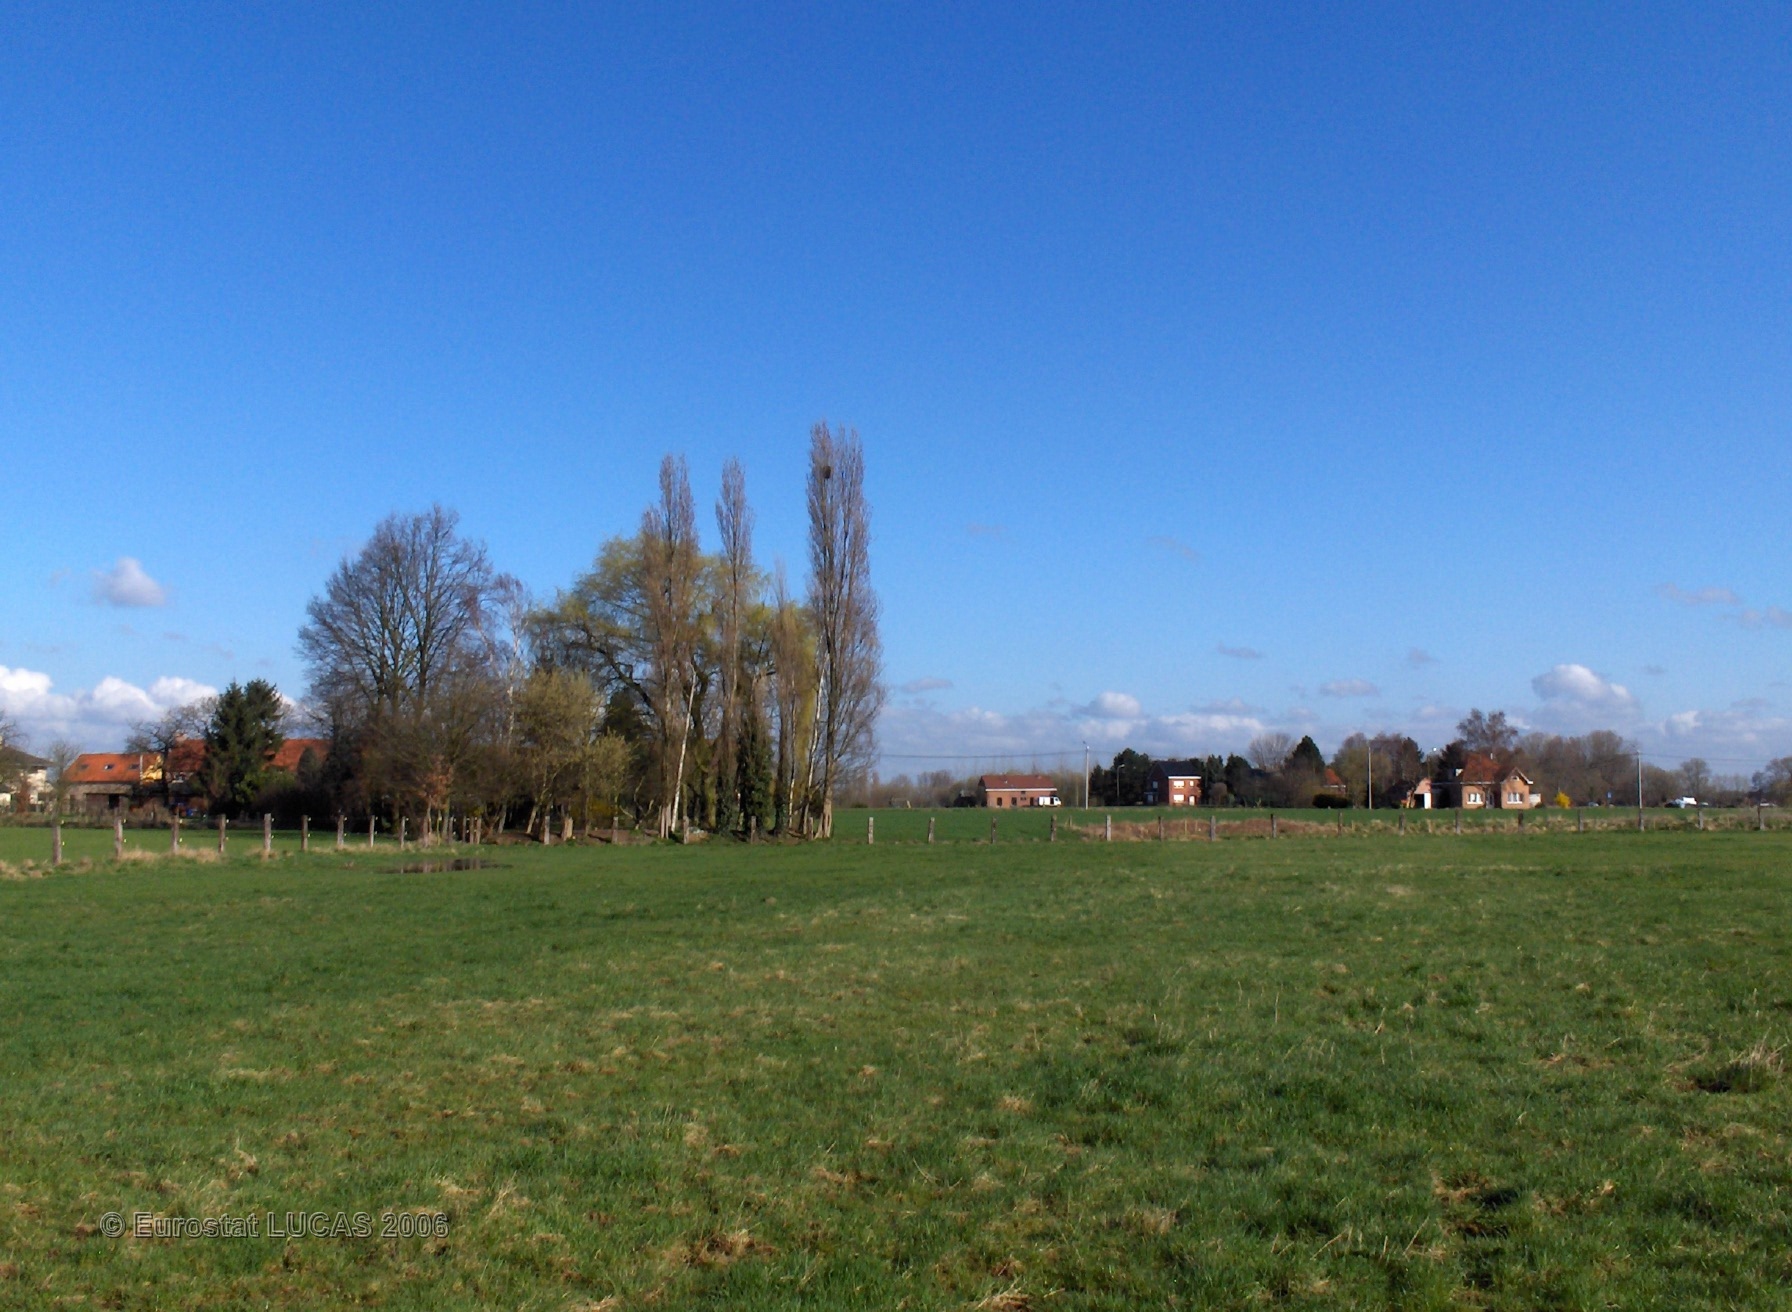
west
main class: Grassland
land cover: Grassland without tree/shrub cover
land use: Agriculture (excluding fallow land and kitchen gardens)
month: April
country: BE
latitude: 50.9851
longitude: 4.4257
